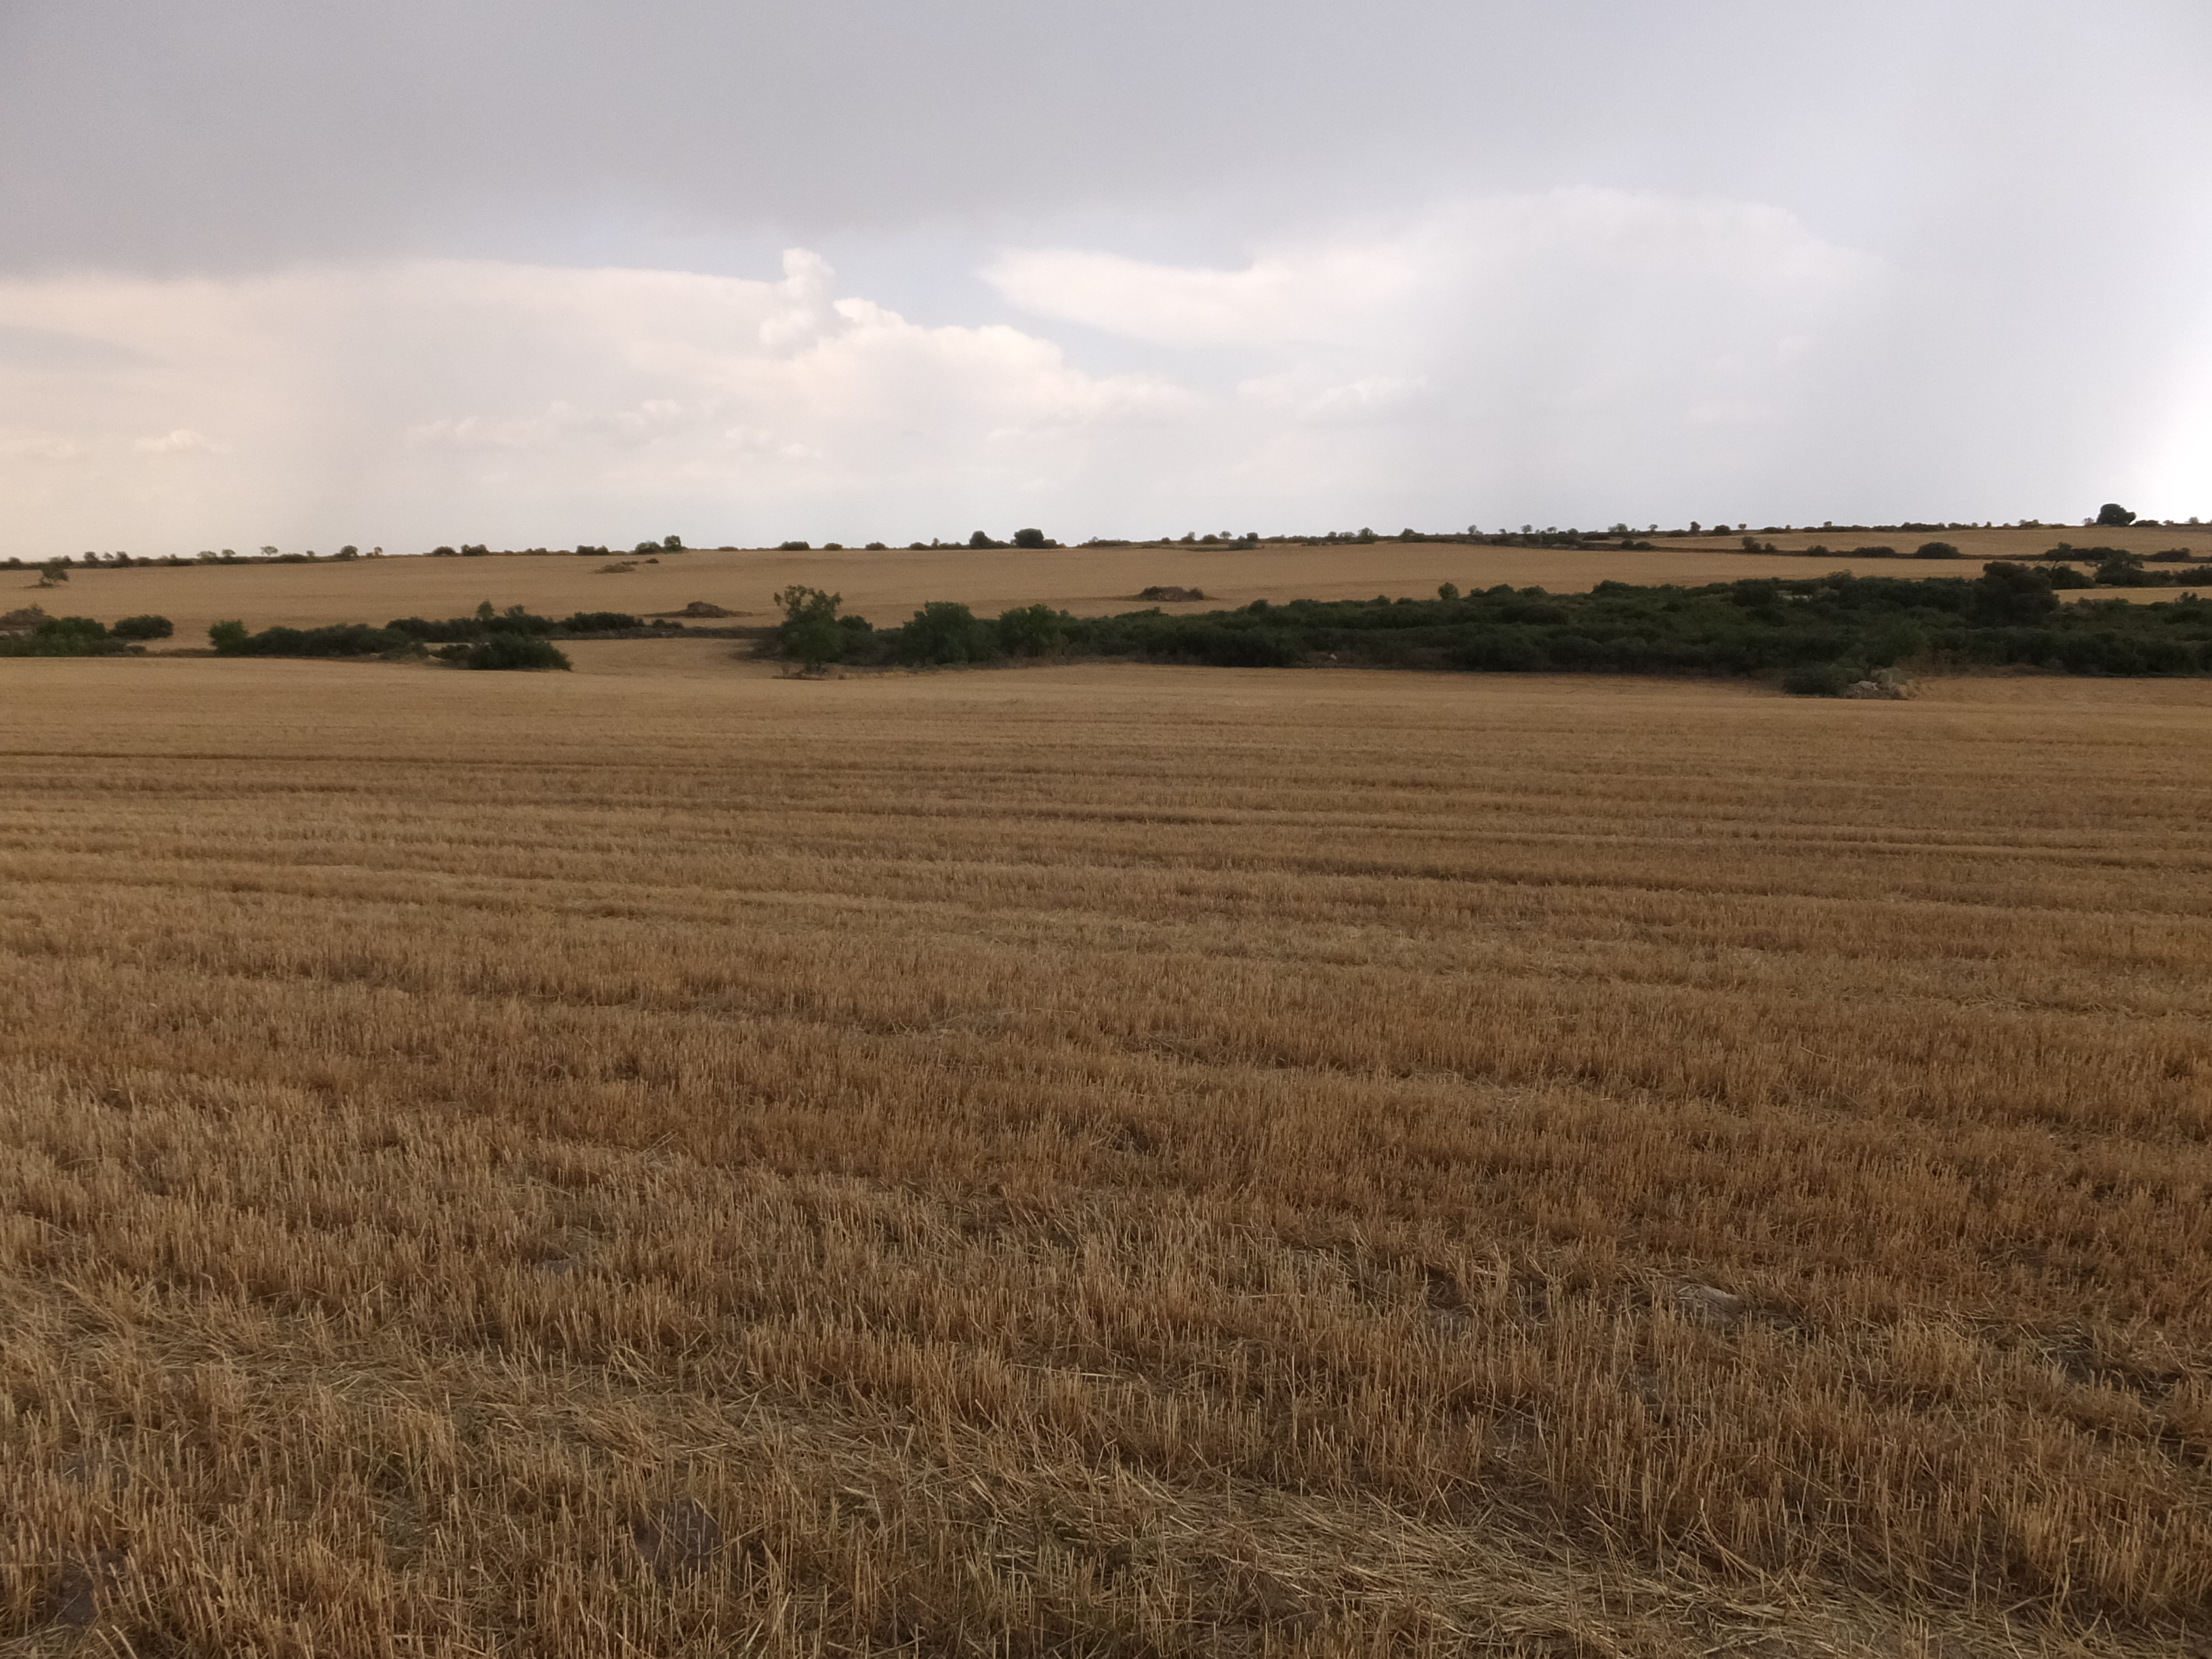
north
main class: Cropland
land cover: Barley
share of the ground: < 10 %
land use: Agriculture (excluding fallow land and kitchen gardens)
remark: Harvested field
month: June
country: ES
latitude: 41.4222
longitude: 0.2839
